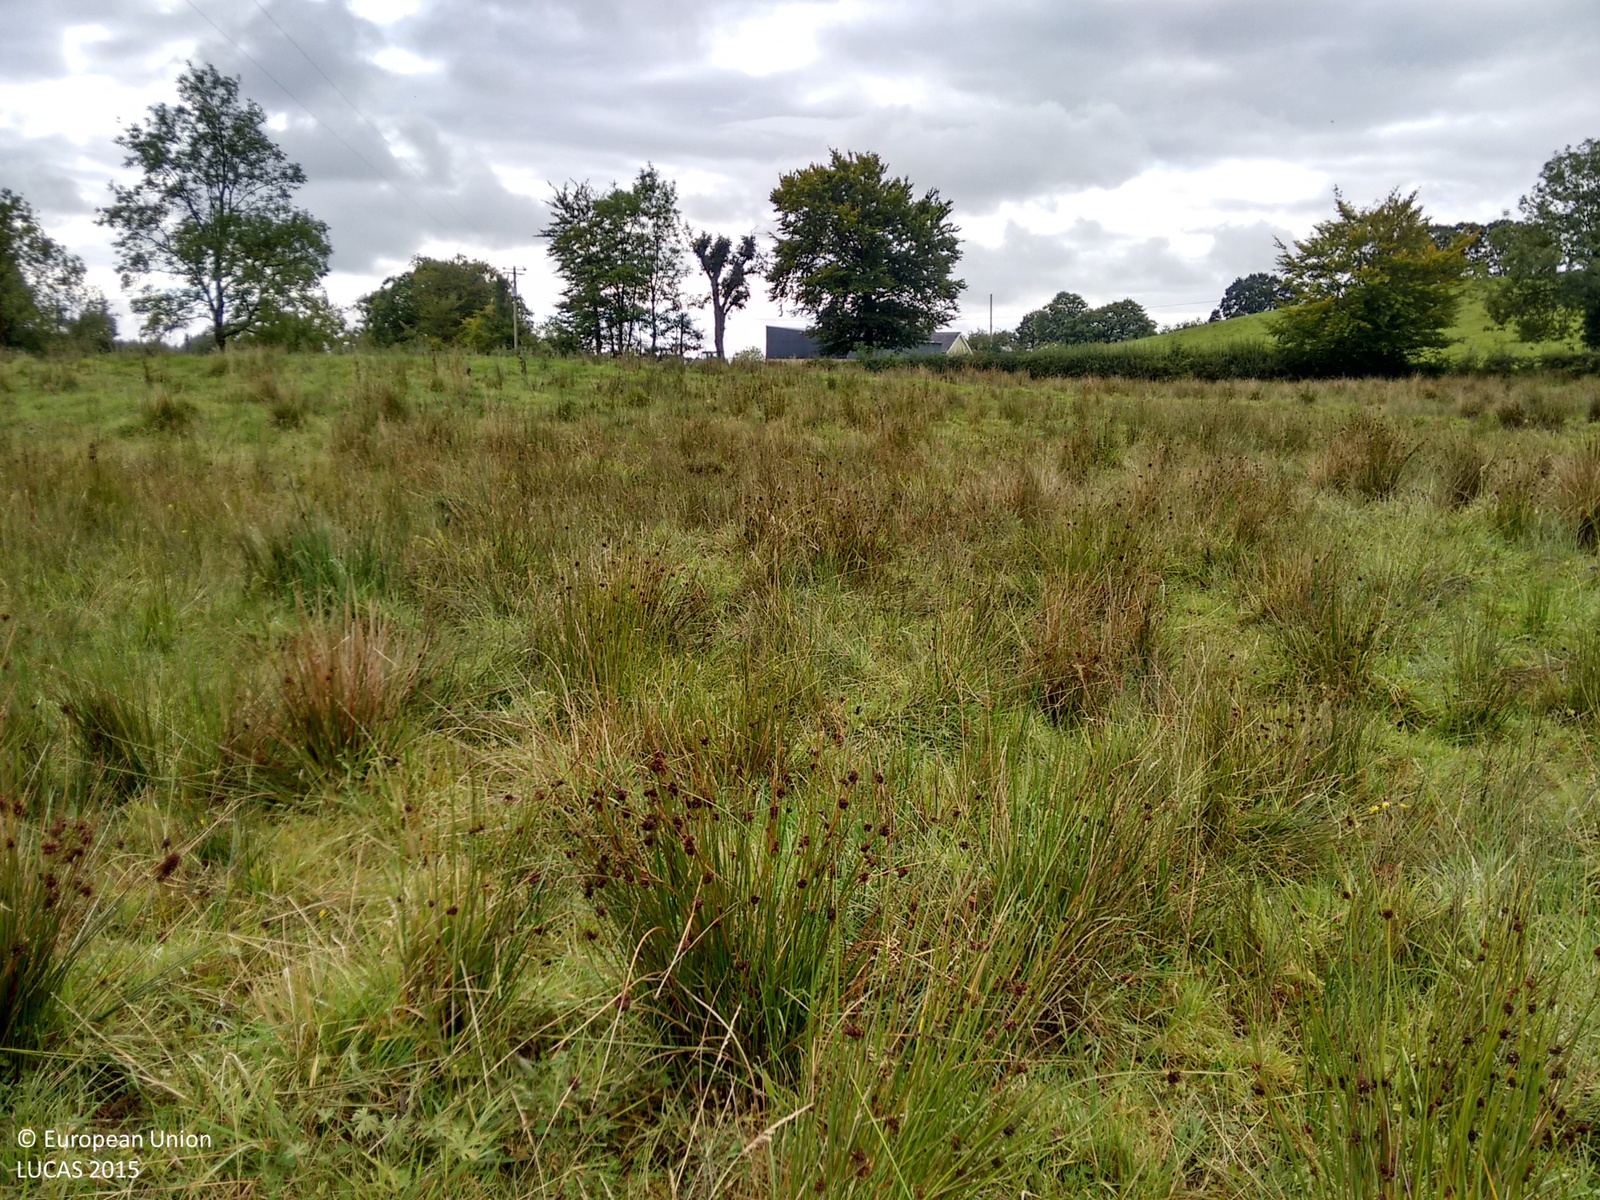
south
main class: Grassland
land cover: Grassland without tree/shrub cover
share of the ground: > 75 %
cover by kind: herbaceous plants 95 %
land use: Agriculture (excluding fallow land and kitchen gardens)
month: September
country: IE
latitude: 52.8943
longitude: -8.7695
